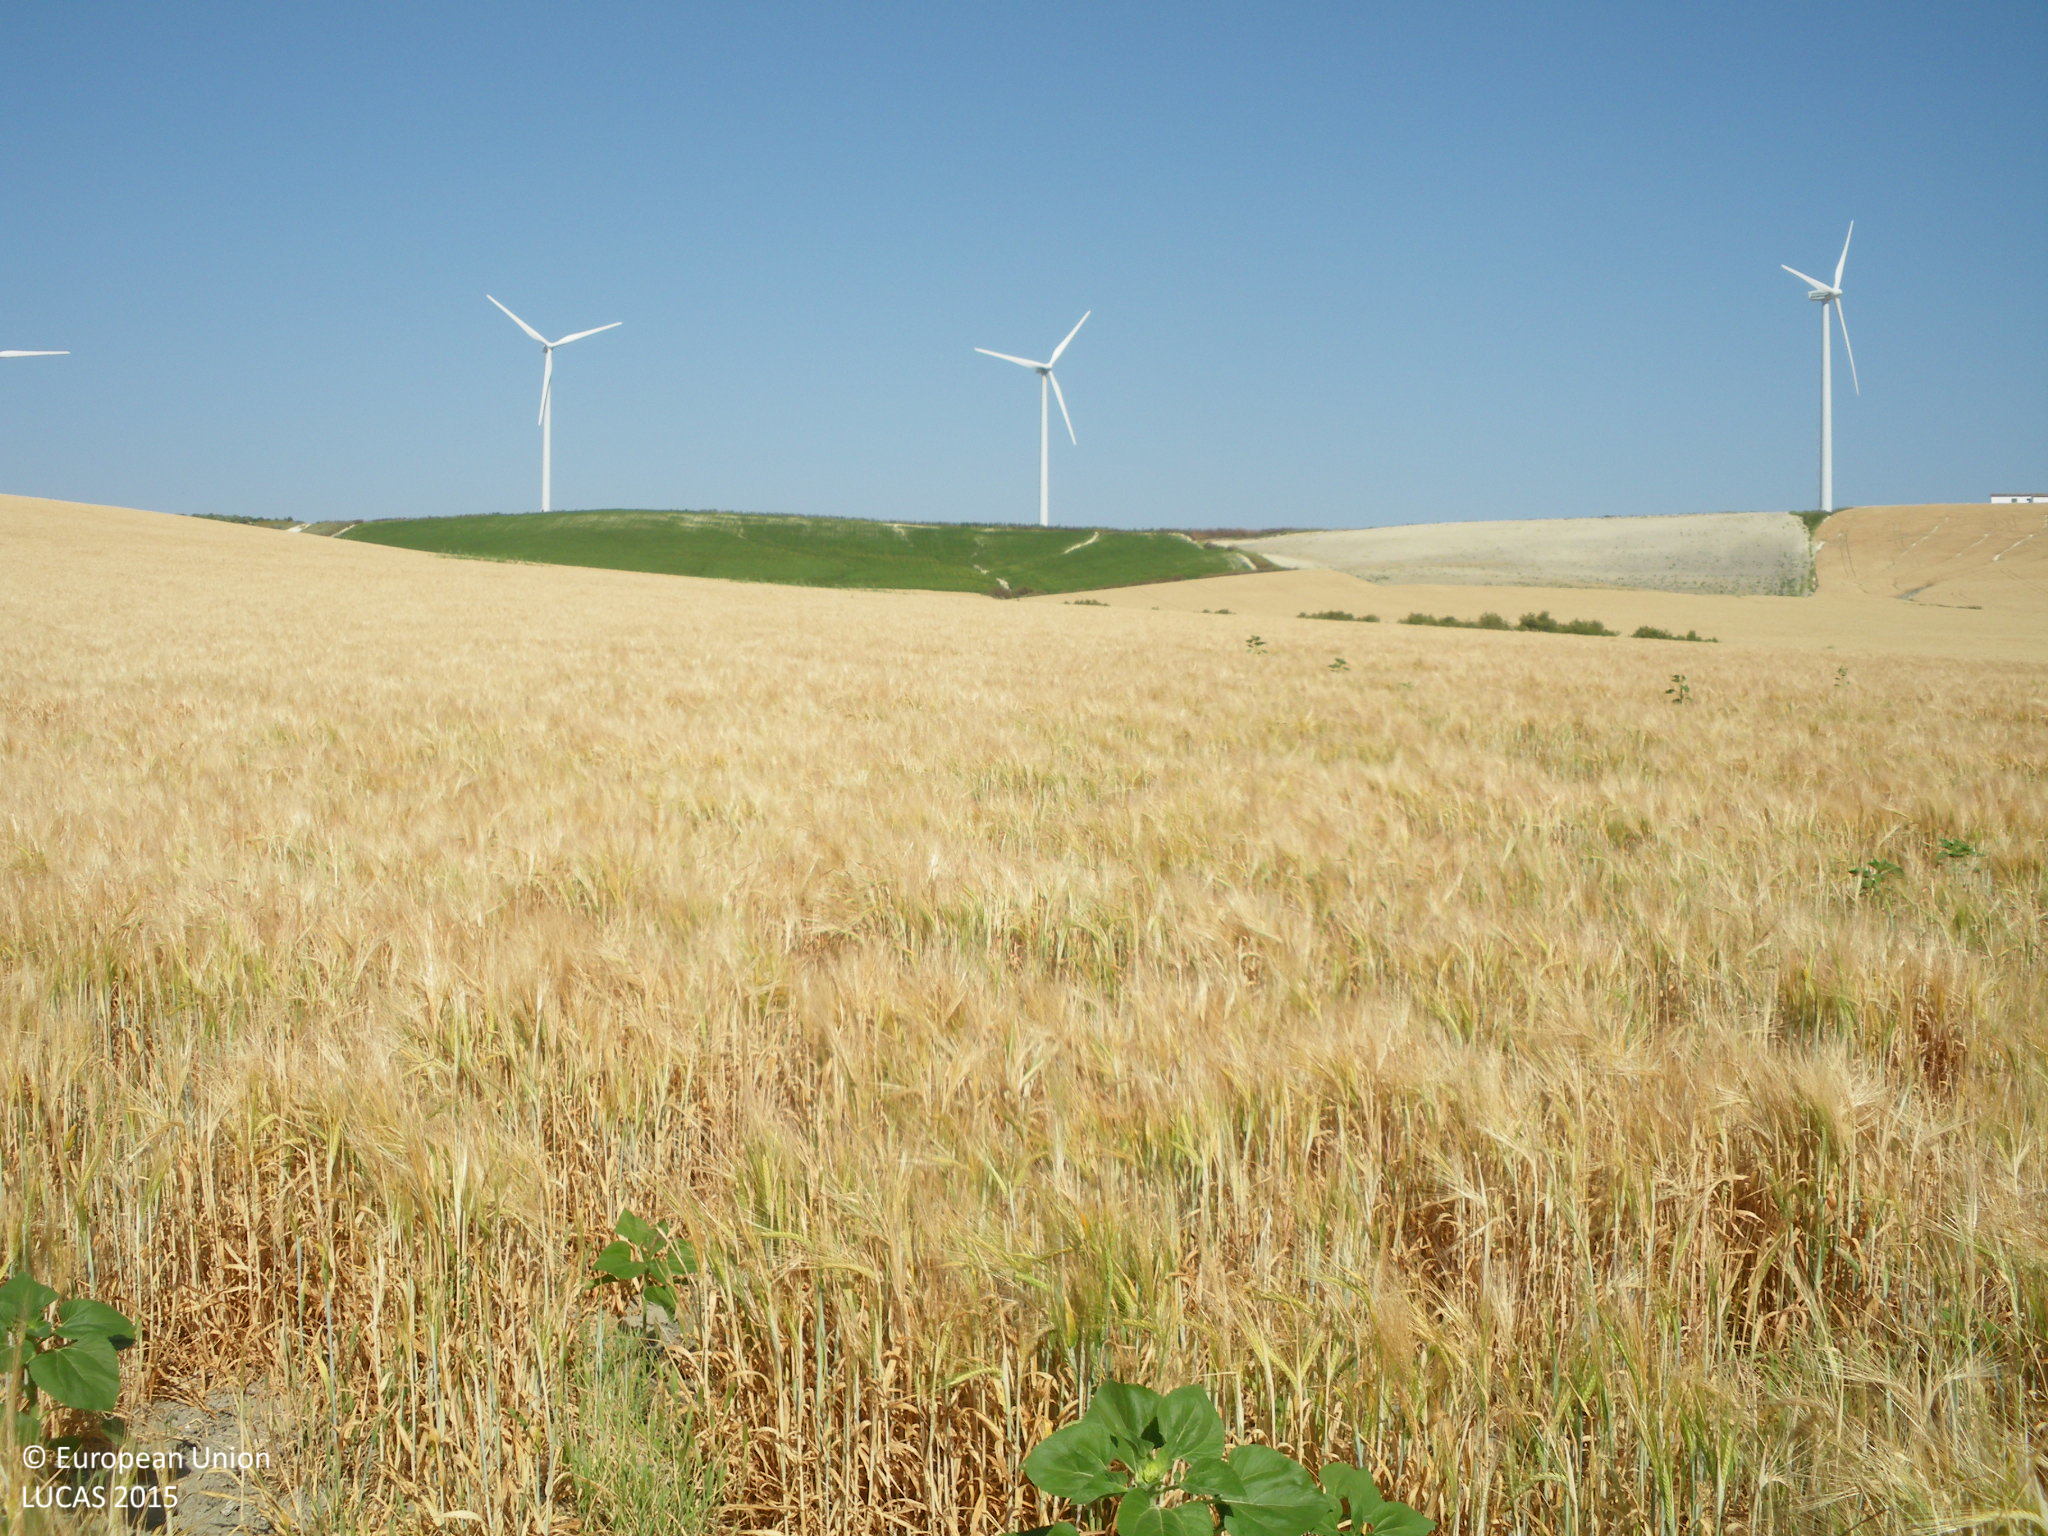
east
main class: Cropland
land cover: Barley
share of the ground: 50 - 75 %
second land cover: Sunflower
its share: < 10 %
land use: Agriculture (excluding fallow land and kitchen gardens)
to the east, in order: Barley; Sunflower; Barley
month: May
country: ES
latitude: 36.7822
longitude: -6.2523
